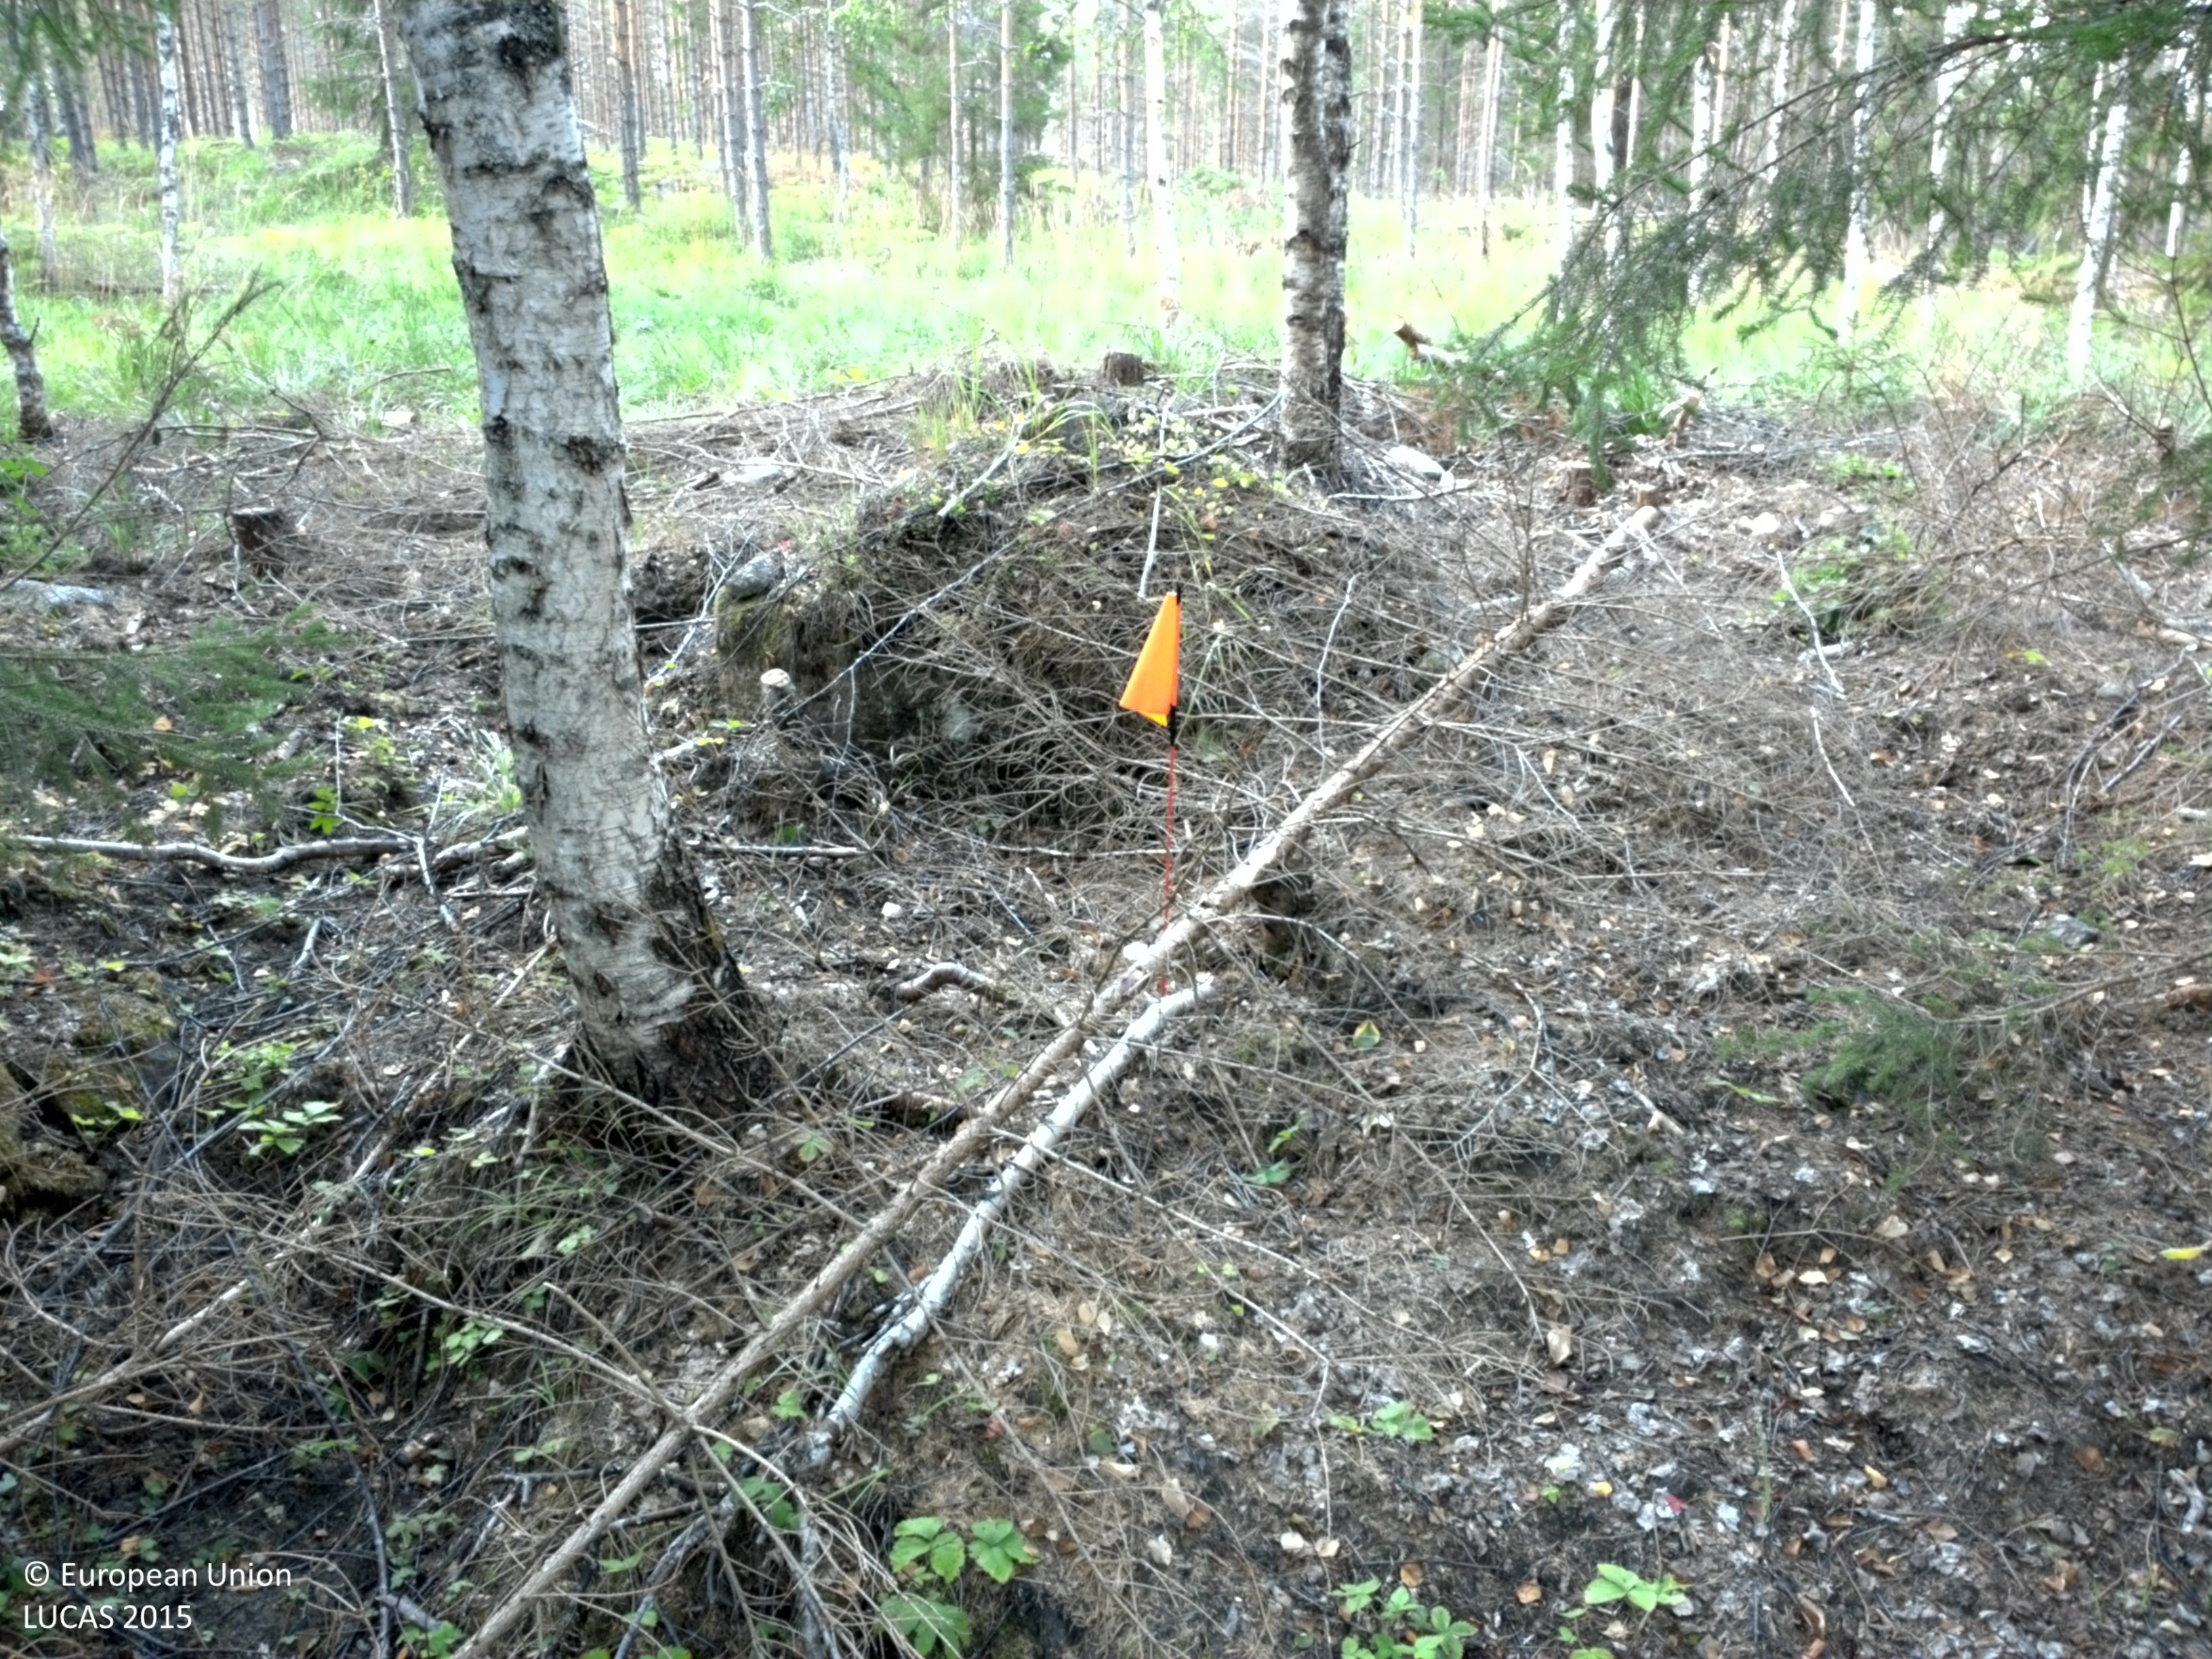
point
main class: Woodland
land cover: Spruce dominated mixed woodland
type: boreal forest
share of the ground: > 75 %
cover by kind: coniferous forest trees 60 %, broadleaved forest trees 20 %, lichens and mosses 20 %
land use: Forestry
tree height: > 5 m
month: August
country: SE
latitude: 60.1084
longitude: 17.8191
